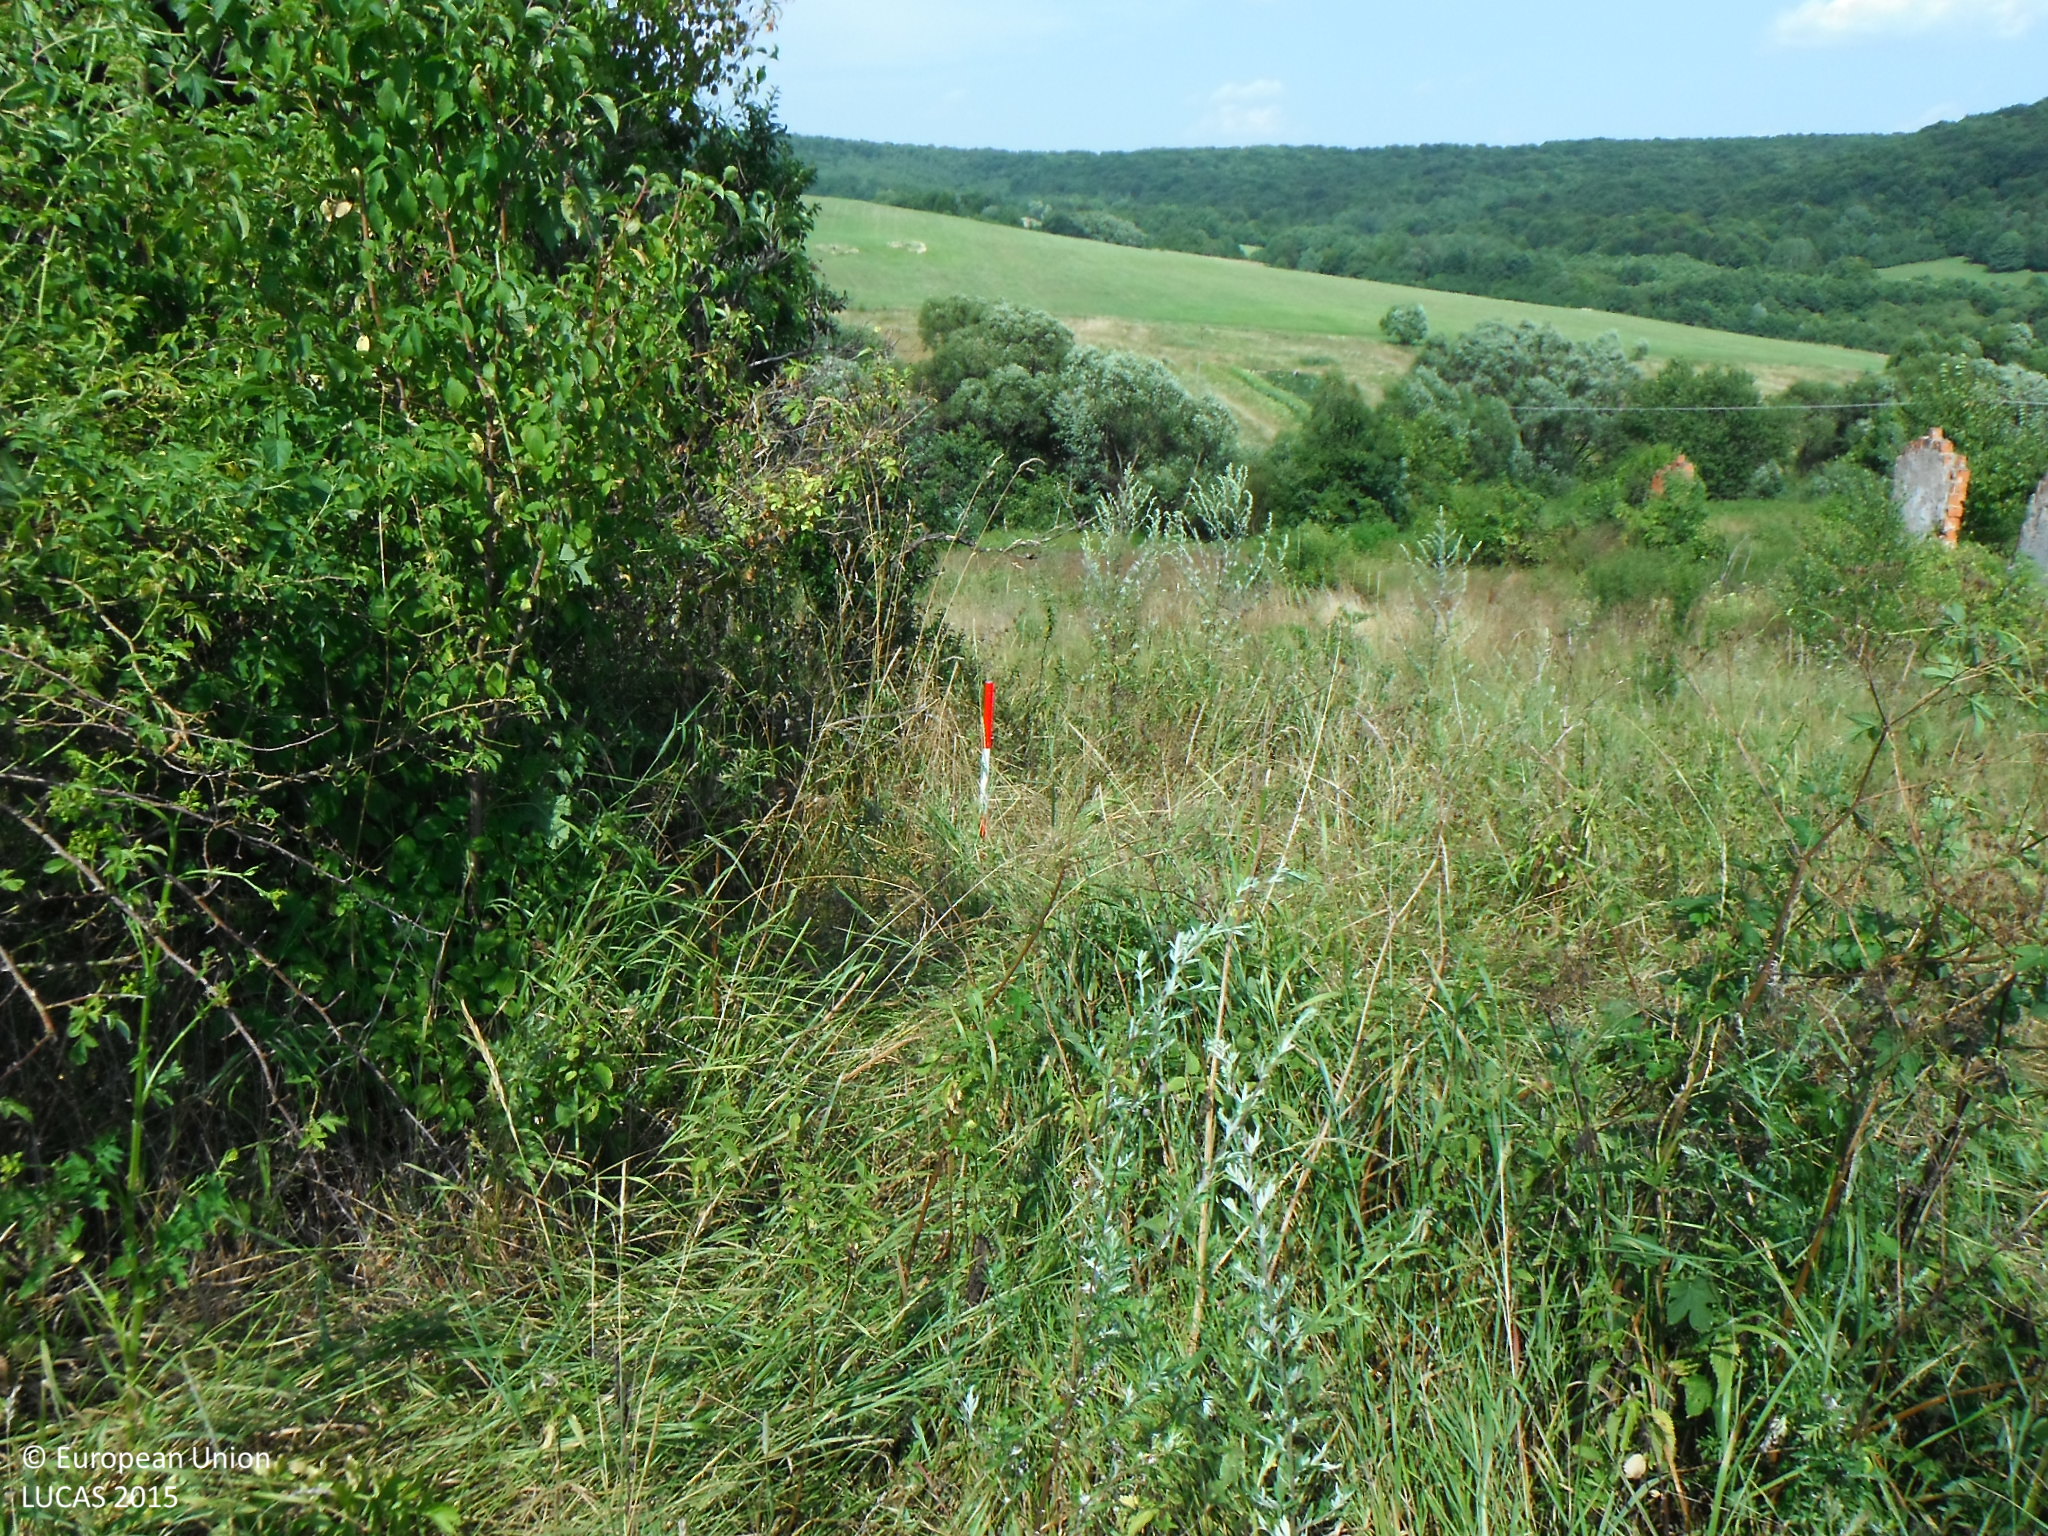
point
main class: Shrubland
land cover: Shrubland with sparse tree cover
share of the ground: 10 - 25 %
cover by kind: herbaceous plants 80 %, shrubs 15 %, broadleaved forest trees 5 %
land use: Abandoned areas
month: July
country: SK
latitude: 49.2741
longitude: 21.6655
